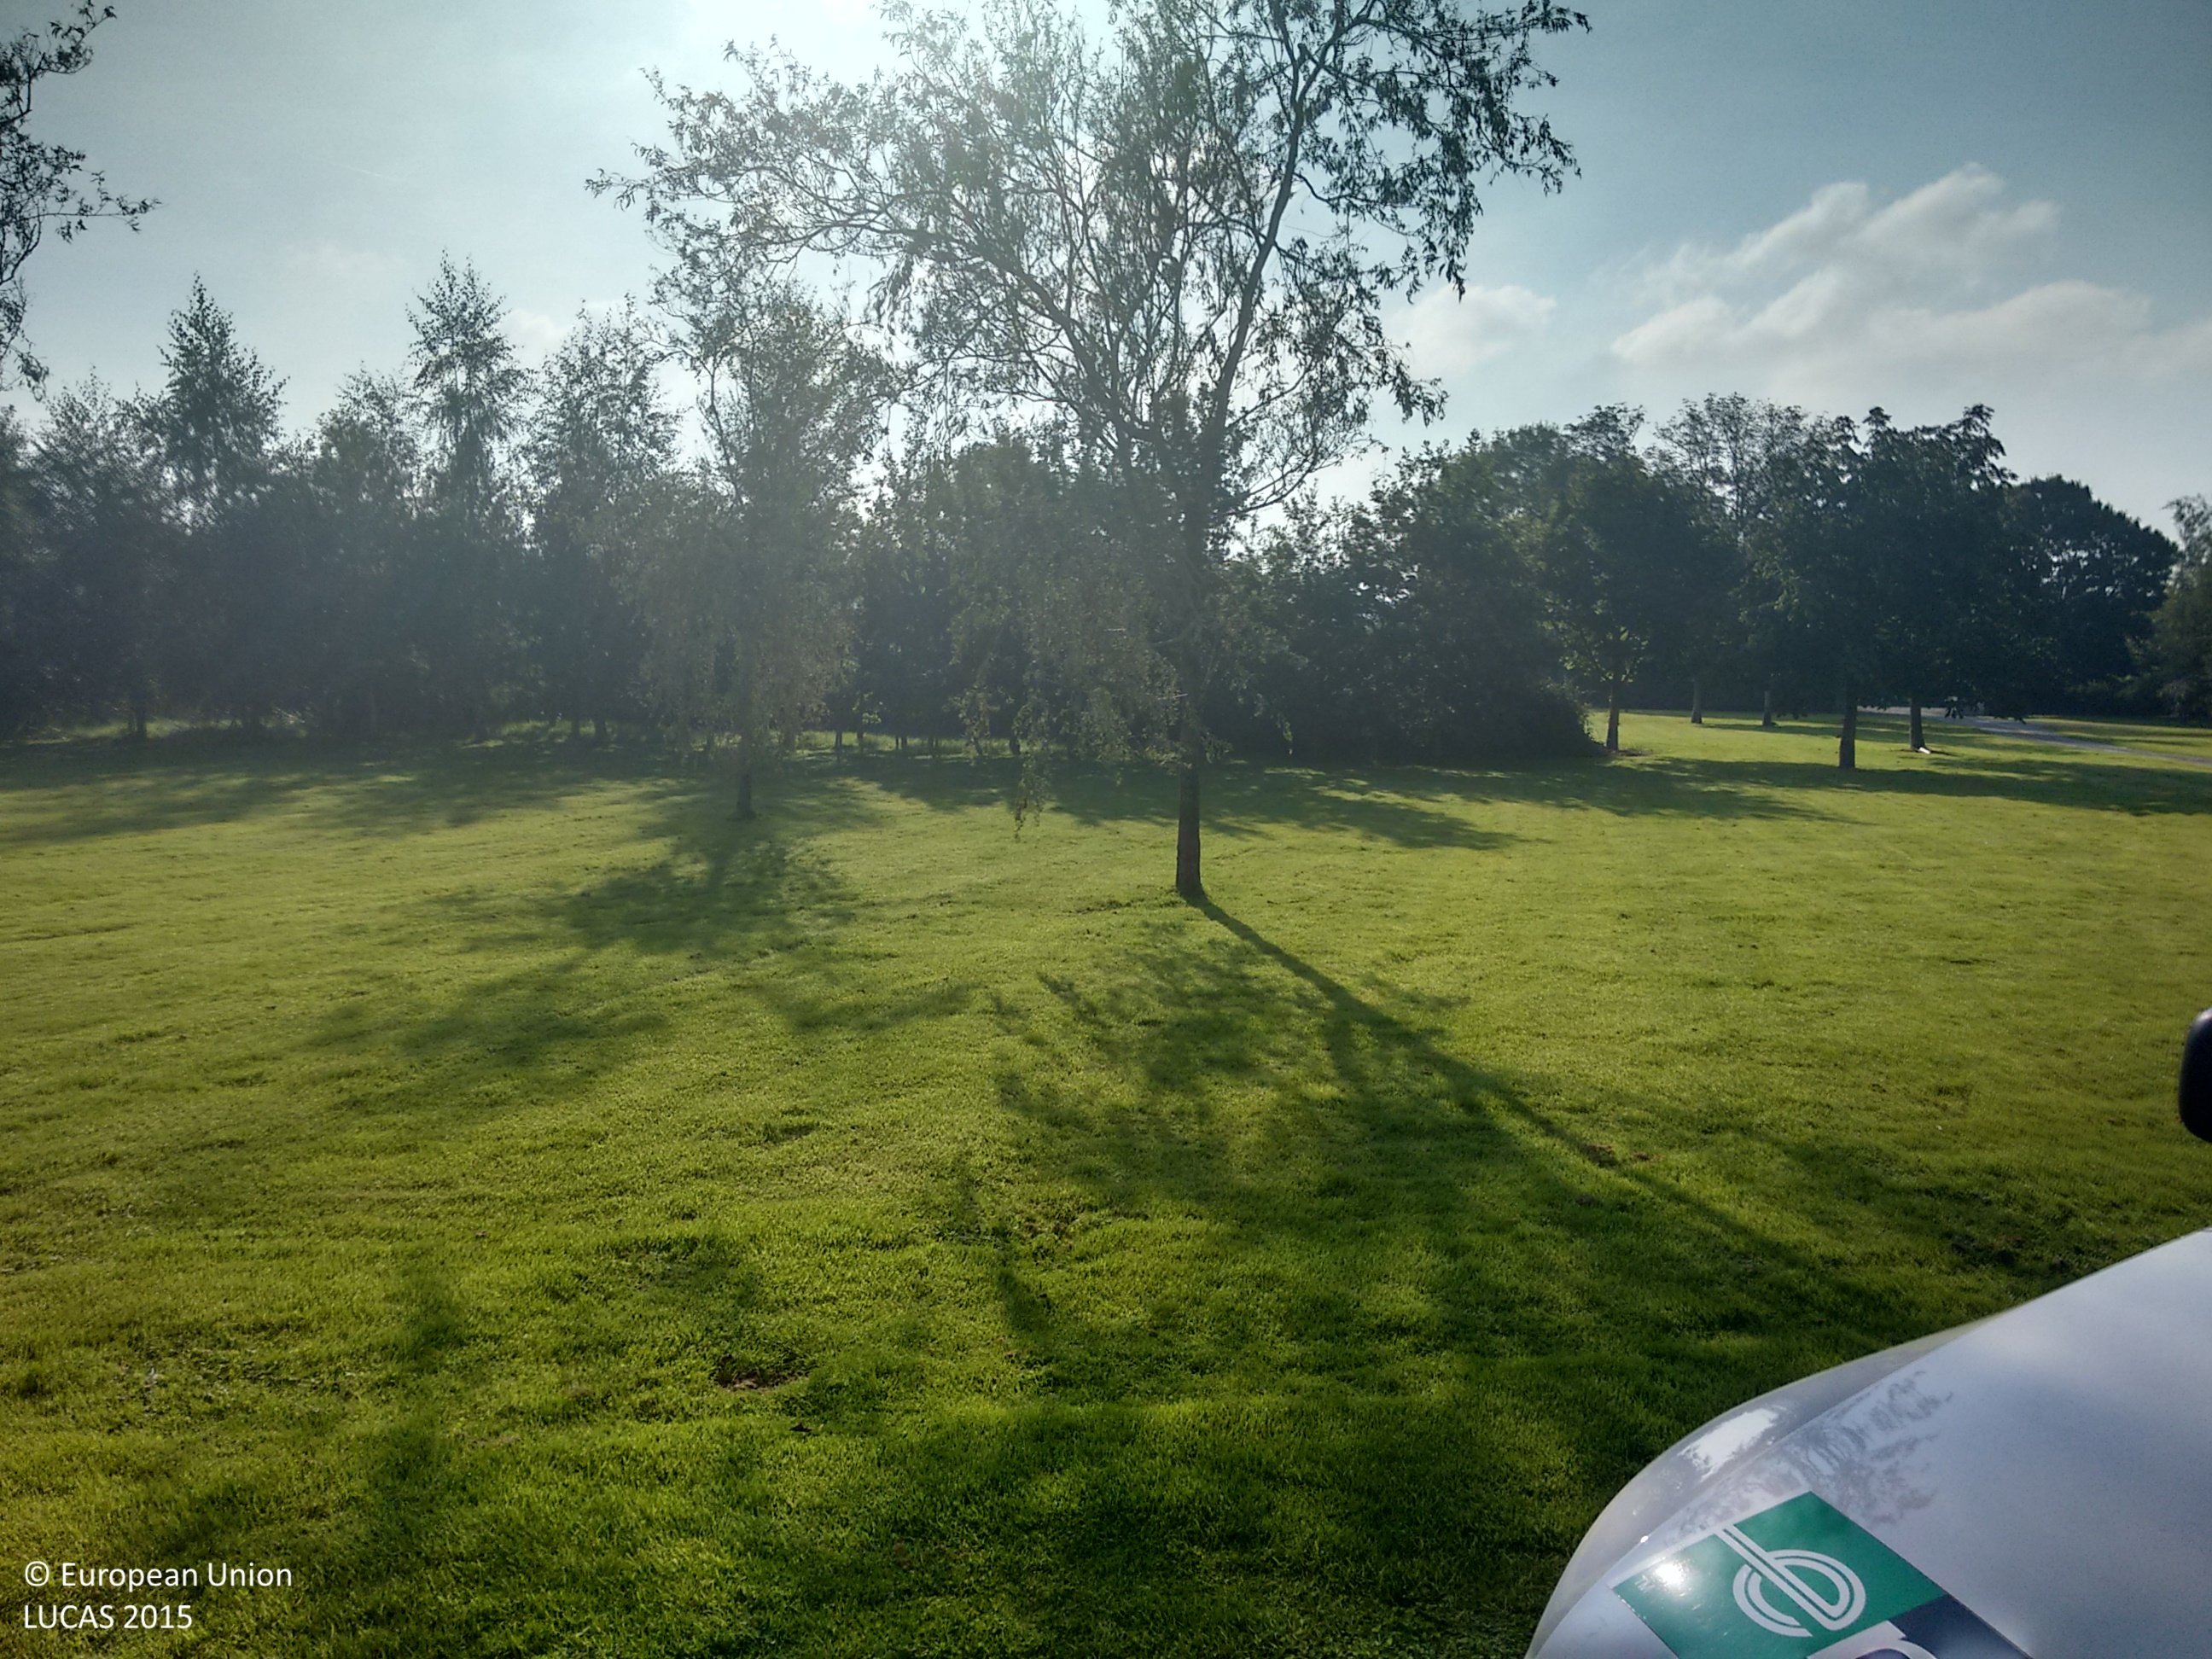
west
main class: Grassland
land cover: Grassland without tree/shrub cover
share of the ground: > 75 %
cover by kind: herbaceous plants 100 %
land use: Residential
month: October
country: IE
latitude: 52.4355
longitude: -9.0885
